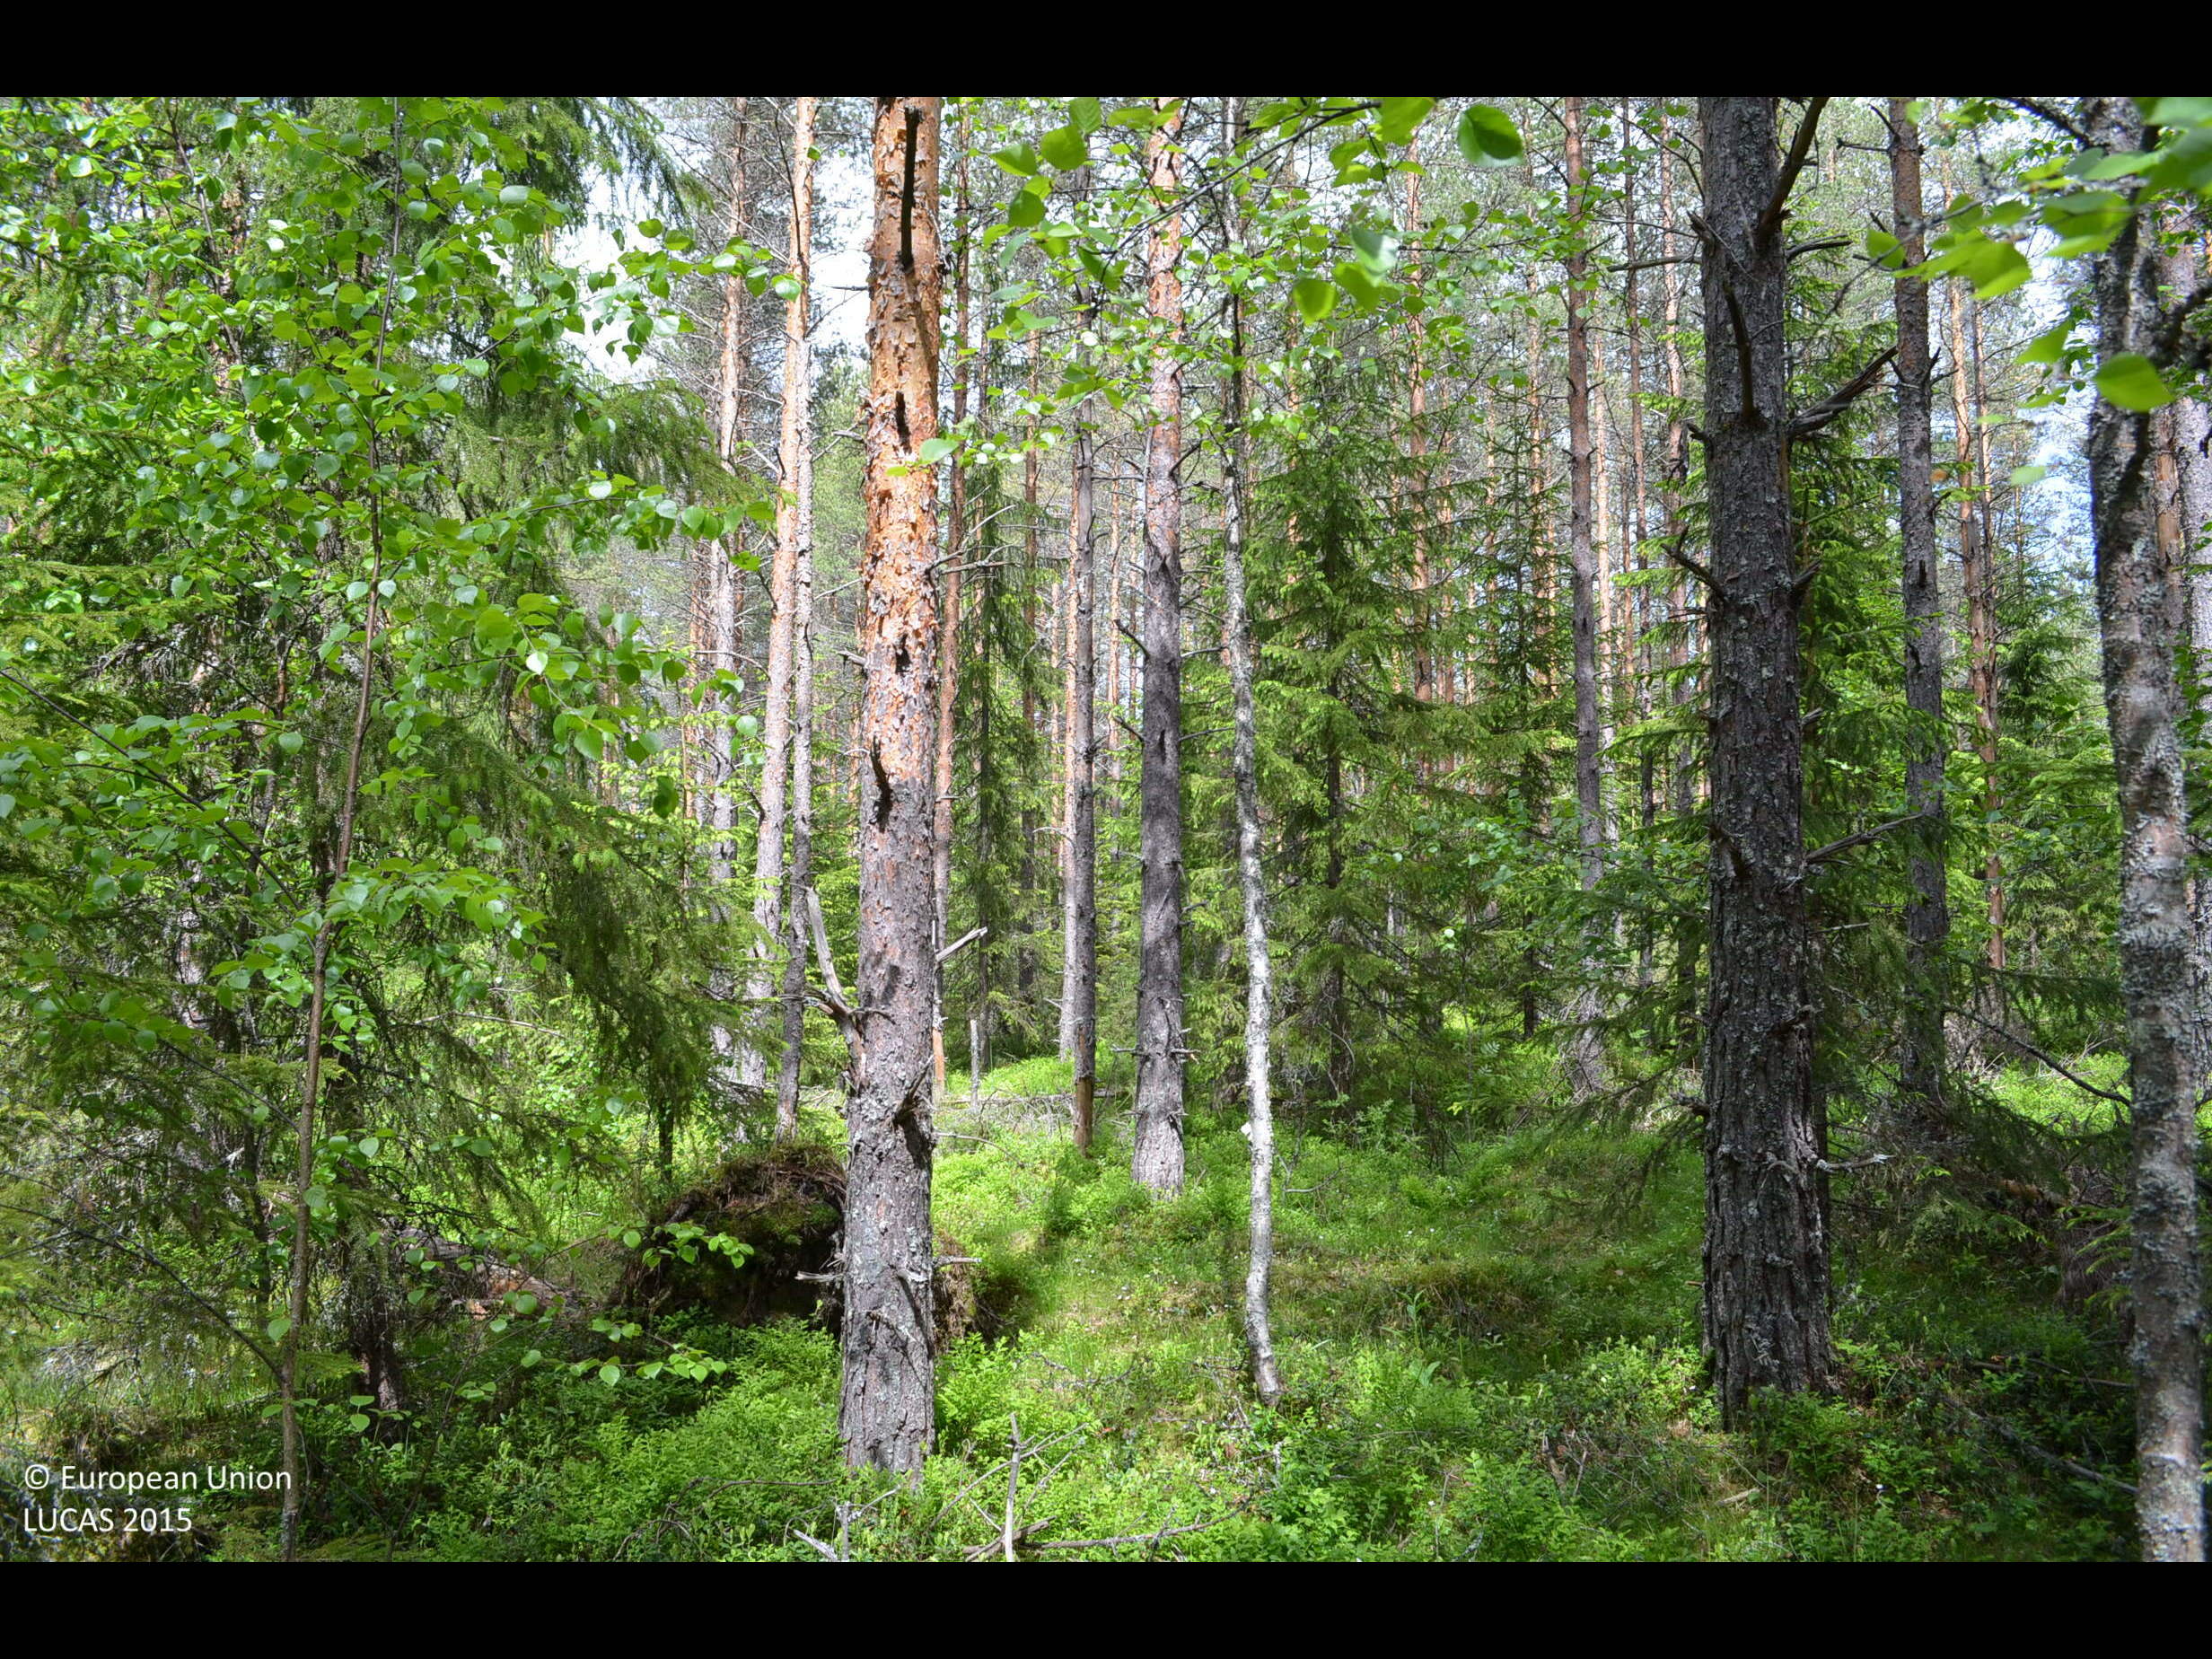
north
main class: Woodland
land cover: Other coniferous woodland
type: boreal forest
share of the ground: > 75 %
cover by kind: coniferous forest trees 75 %, herbaceous plants 20 %, broadleaved forest trees 5 %
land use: Forestry
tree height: > 5 m
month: June
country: FI
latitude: 62.0037
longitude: 23.2668
